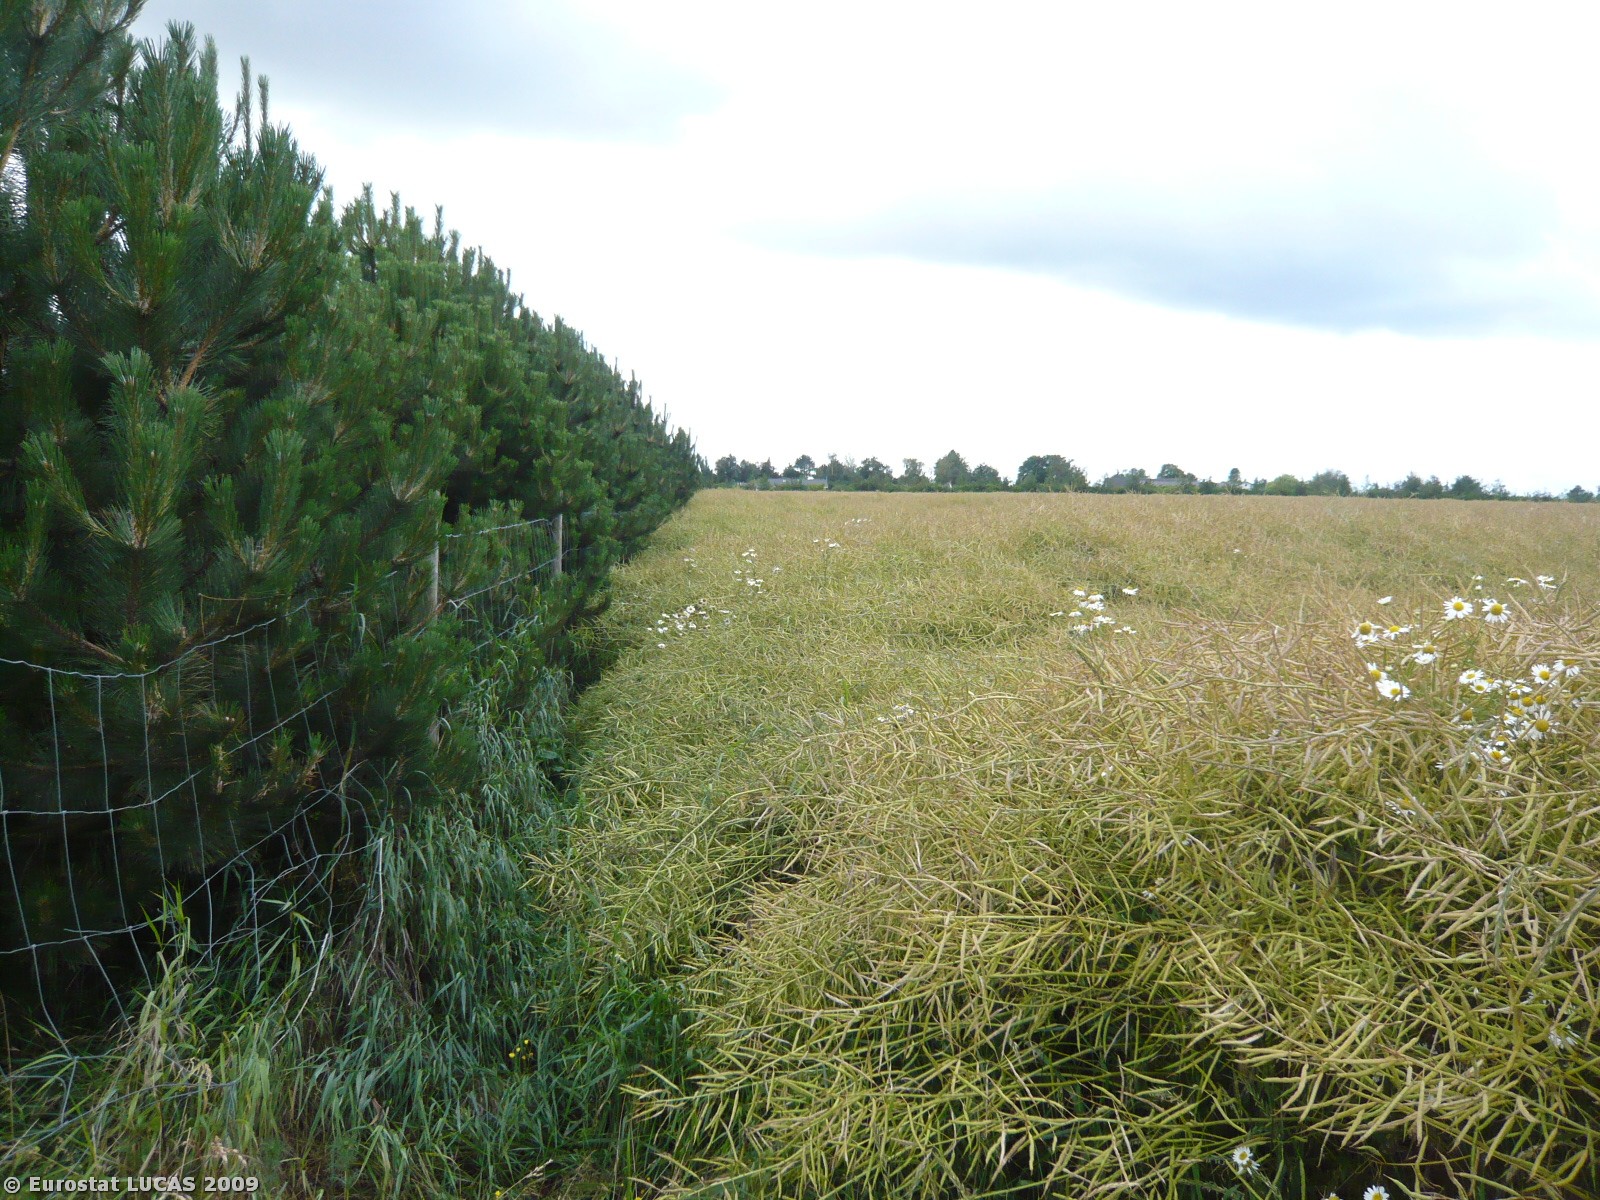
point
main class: Cropland
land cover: Rape and turnip rape
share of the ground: > 75 %
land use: Agriculture (excluding fallow land and kitchen gardens)
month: July
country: DK
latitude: 55.4090
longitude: 11.2151
